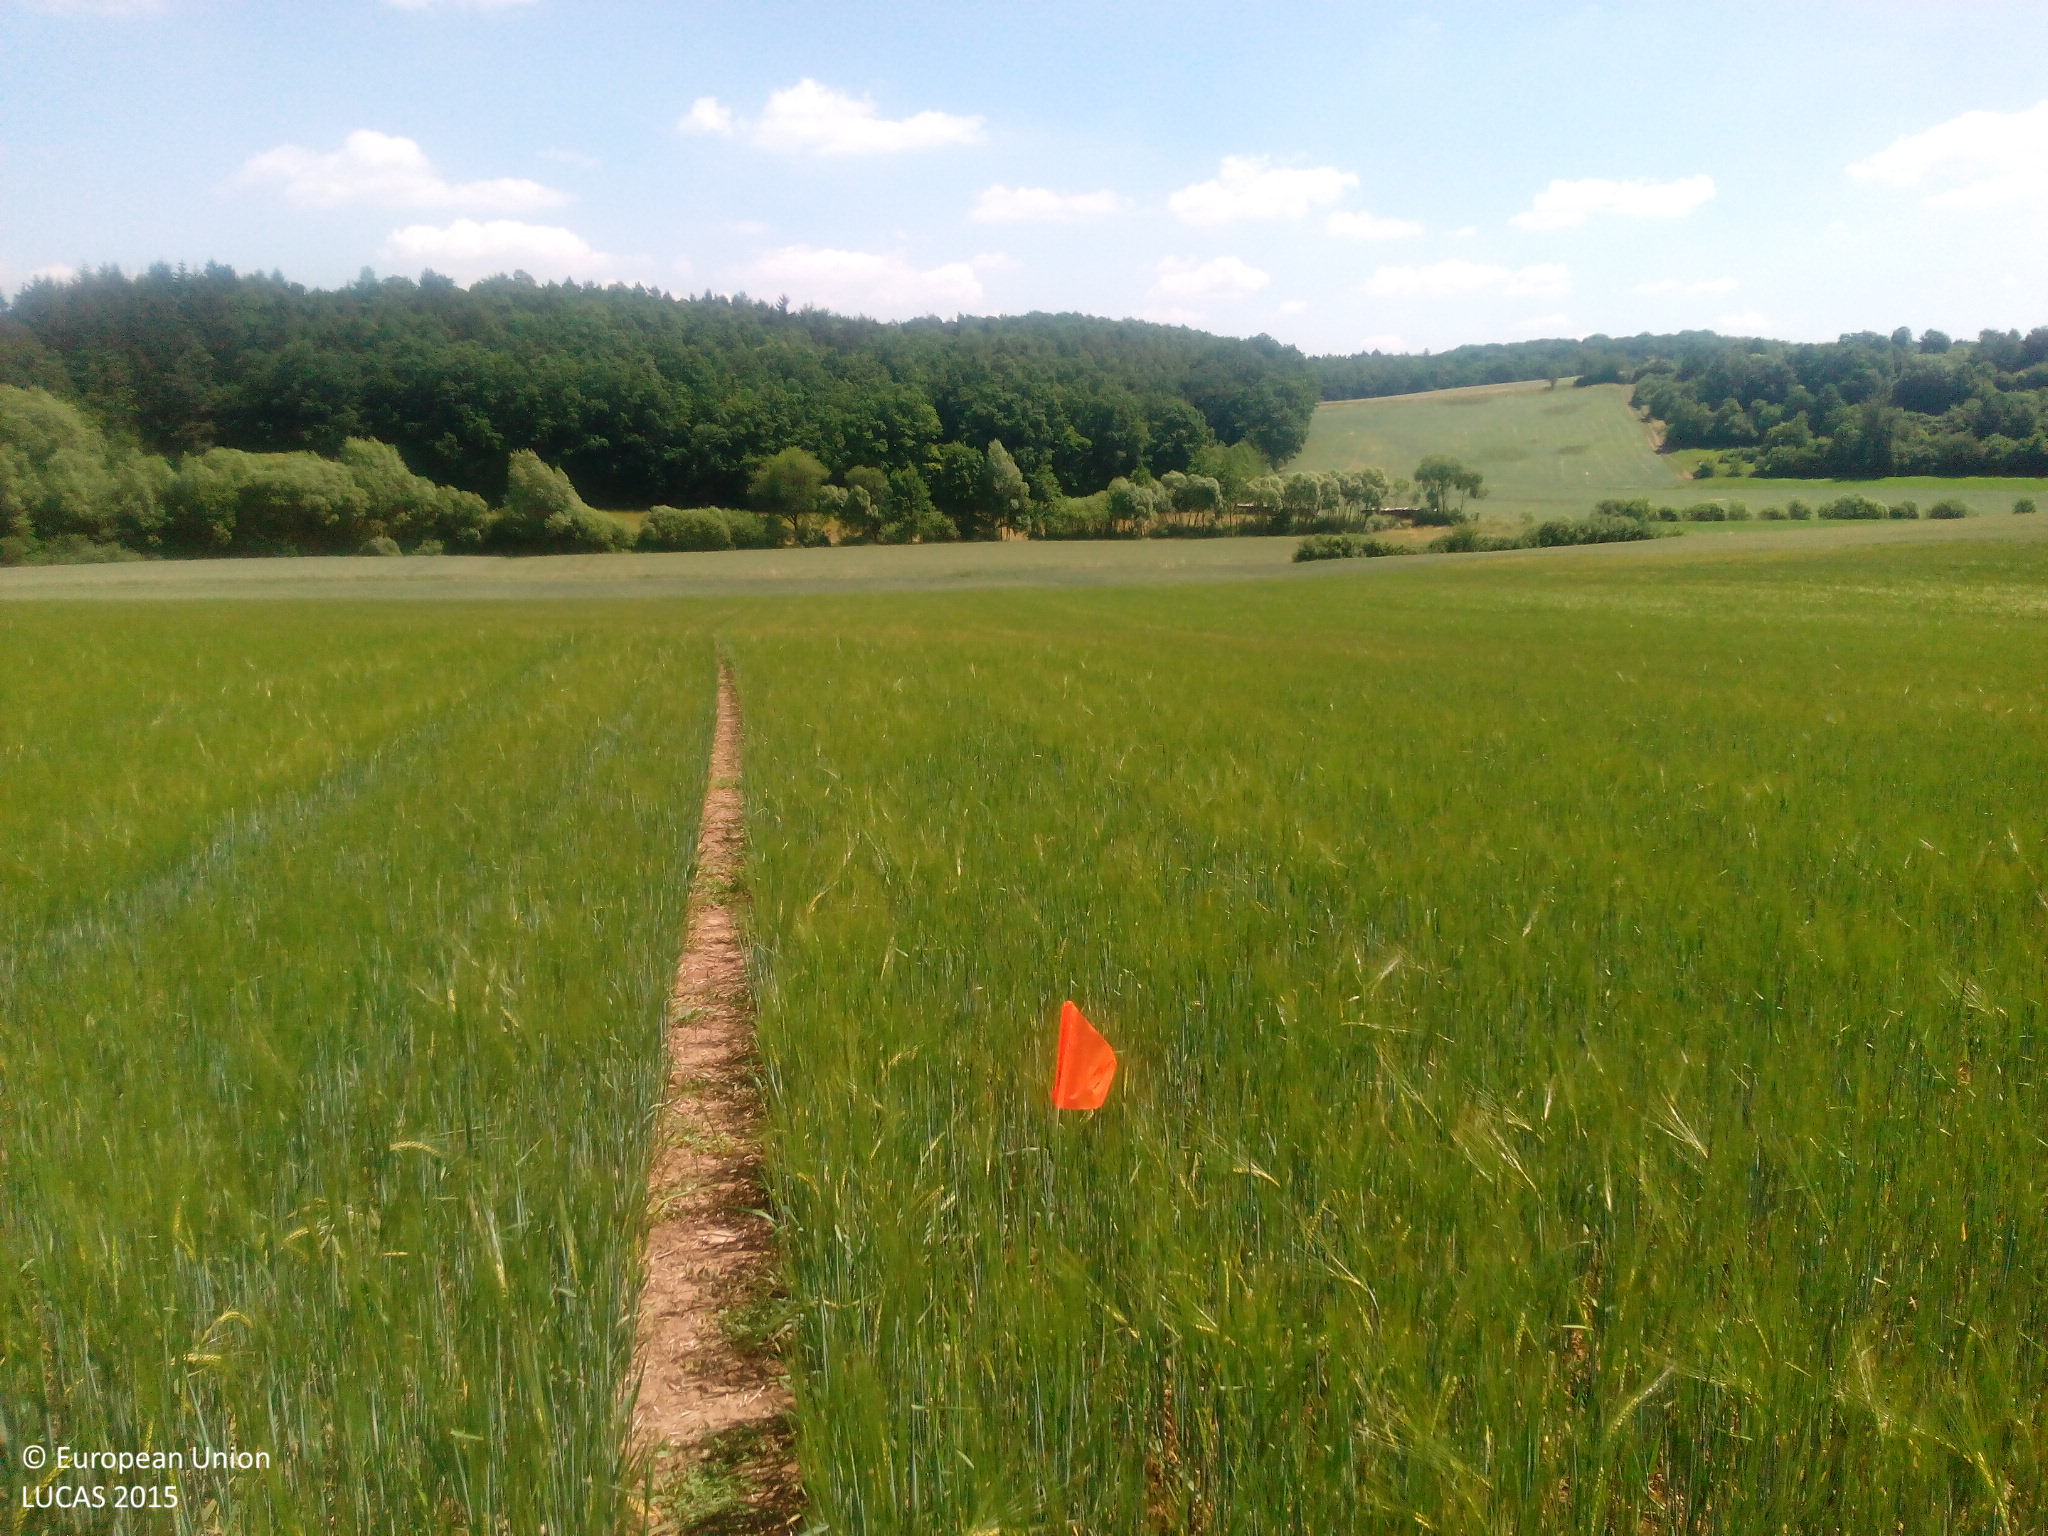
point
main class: Cropland
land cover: Barley
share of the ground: > 75 %
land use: Agriculture (excluding fallow land and kitchen gardens)
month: June
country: DE
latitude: 50.2184
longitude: 10.6305
